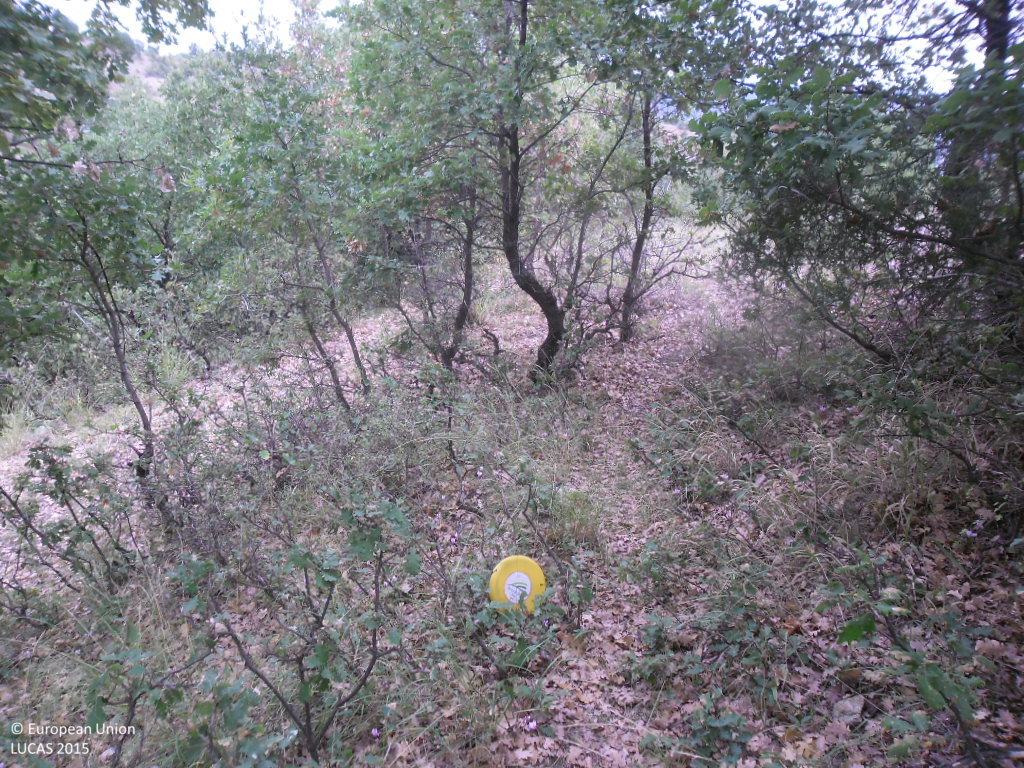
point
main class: Woodland
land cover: Broadleaved woodland
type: thermophilous deciduous forest
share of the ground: > 75 %
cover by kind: broadleaved forest trees 95 %, unconsolidated bare surface 5 %
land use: Forestry
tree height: < 5 m
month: September
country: BG
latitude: 41.6053
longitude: 23.1839
